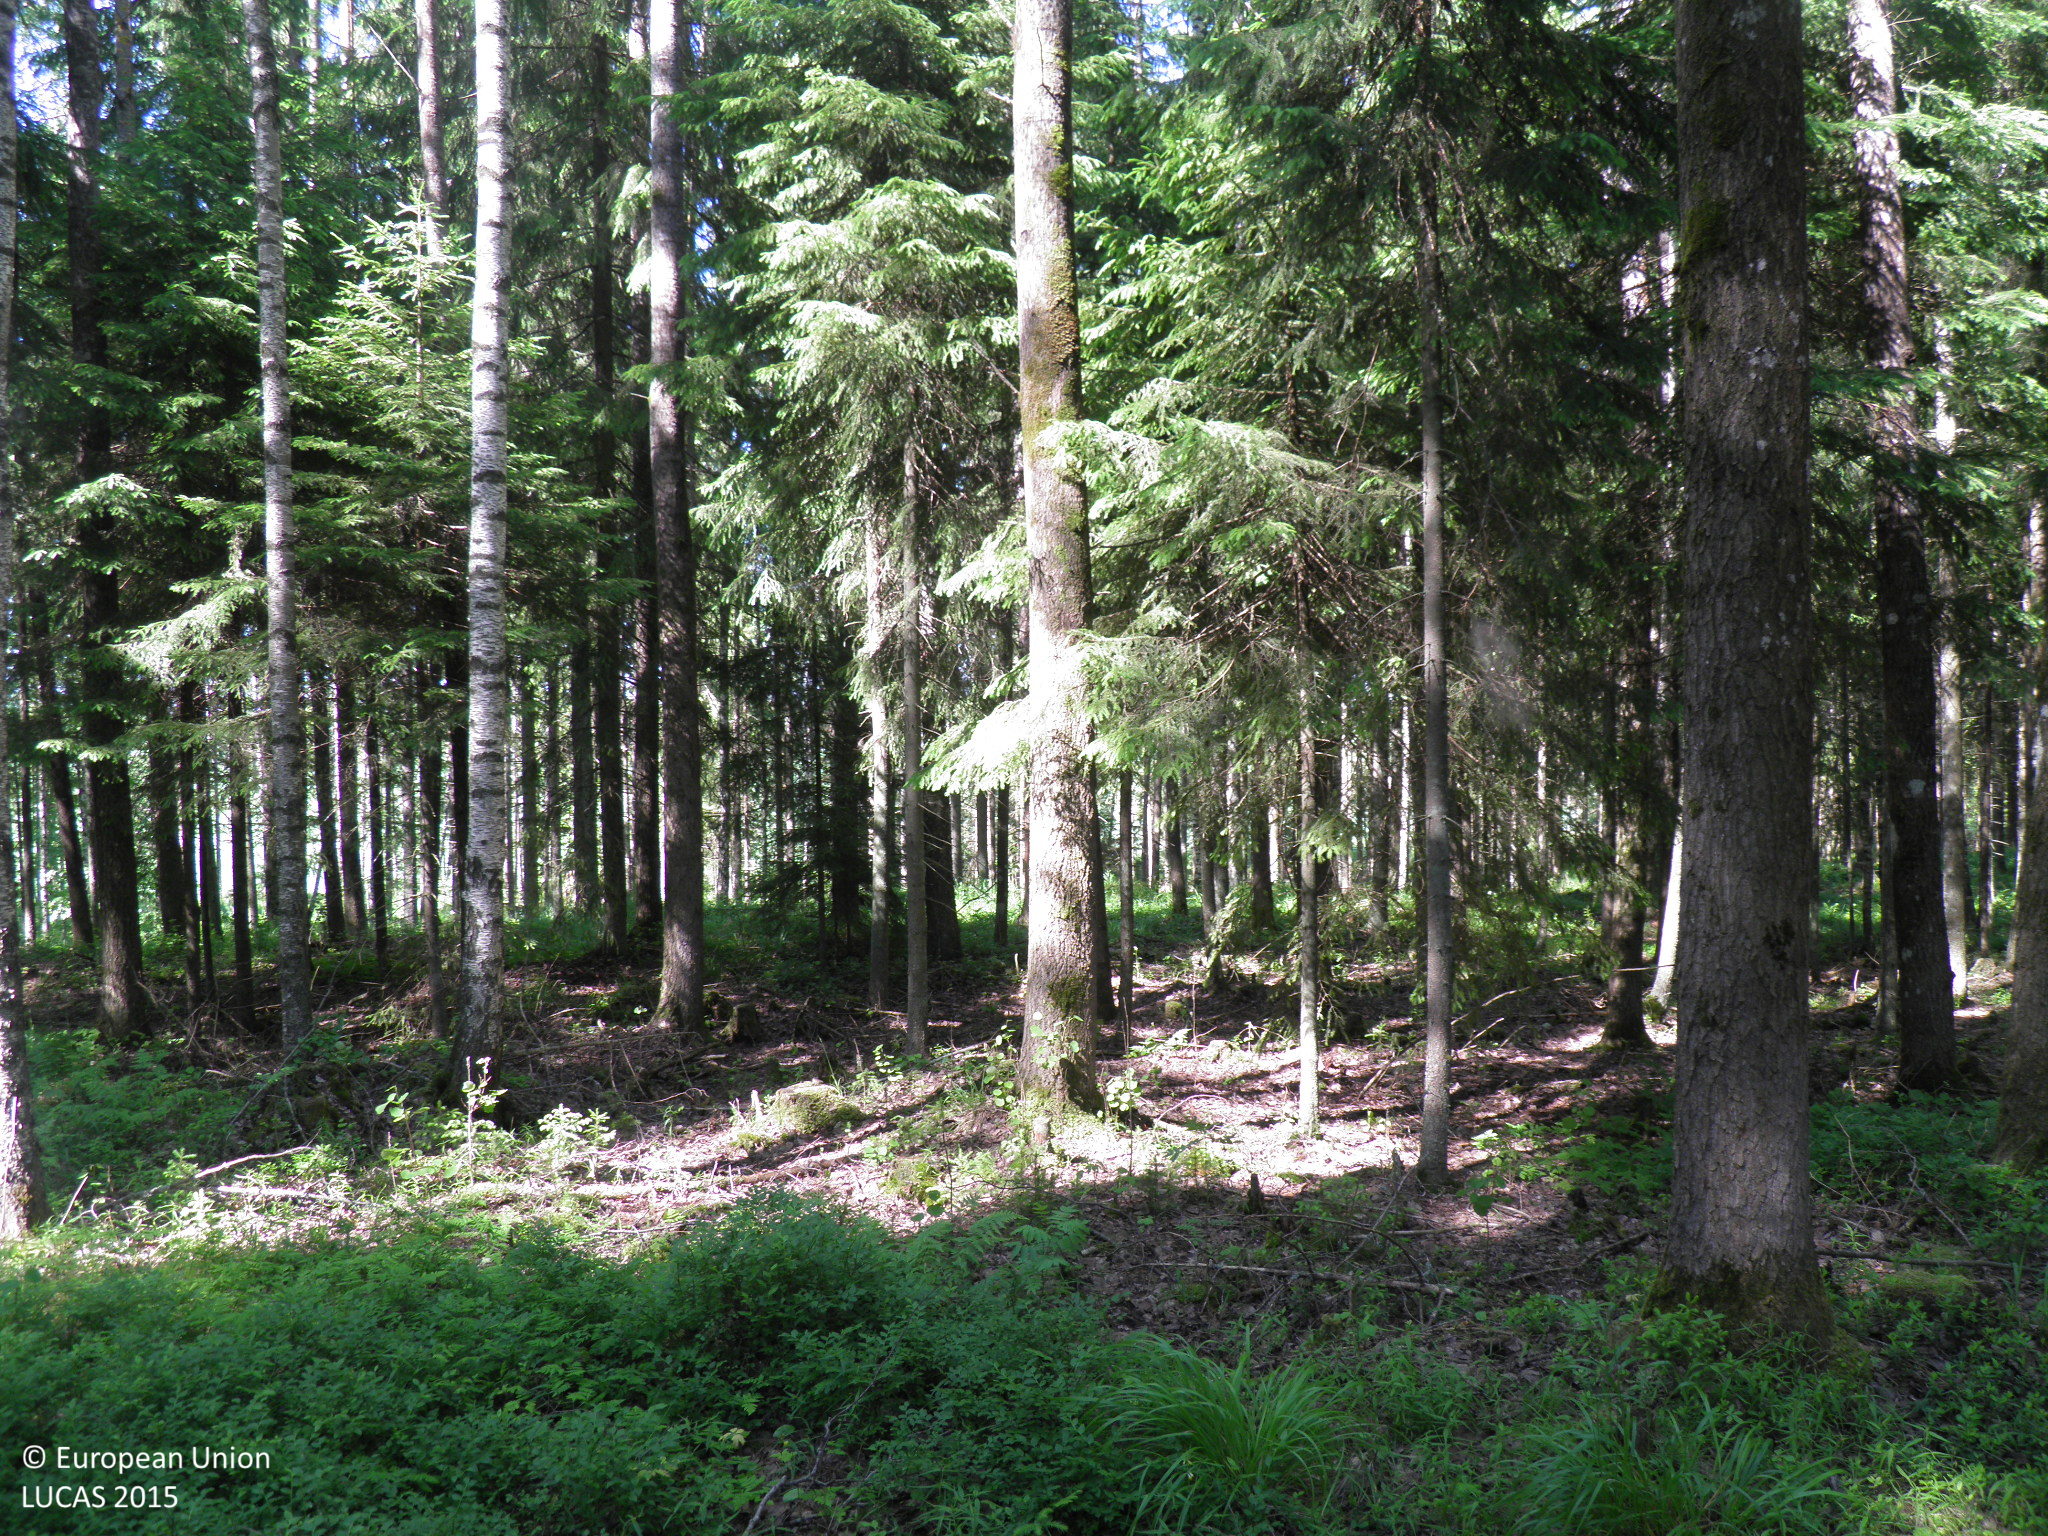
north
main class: Woodland
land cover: Spruce dominated mixed woodland
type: hemiboreal forest and nemoral coniferous forest and mixed broadleaved-coniferous forest
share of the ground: 50 - 75 %
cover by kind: coniferous forest trees 35 %, broadleaved forest trees 35 %, shrubs 10 %, herbaceous plants 10 %, unconsolidated bare surface 10 %
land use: Forestry
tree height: > 5 m
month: June
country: FI
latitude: 60.4661
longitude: 22.8612
